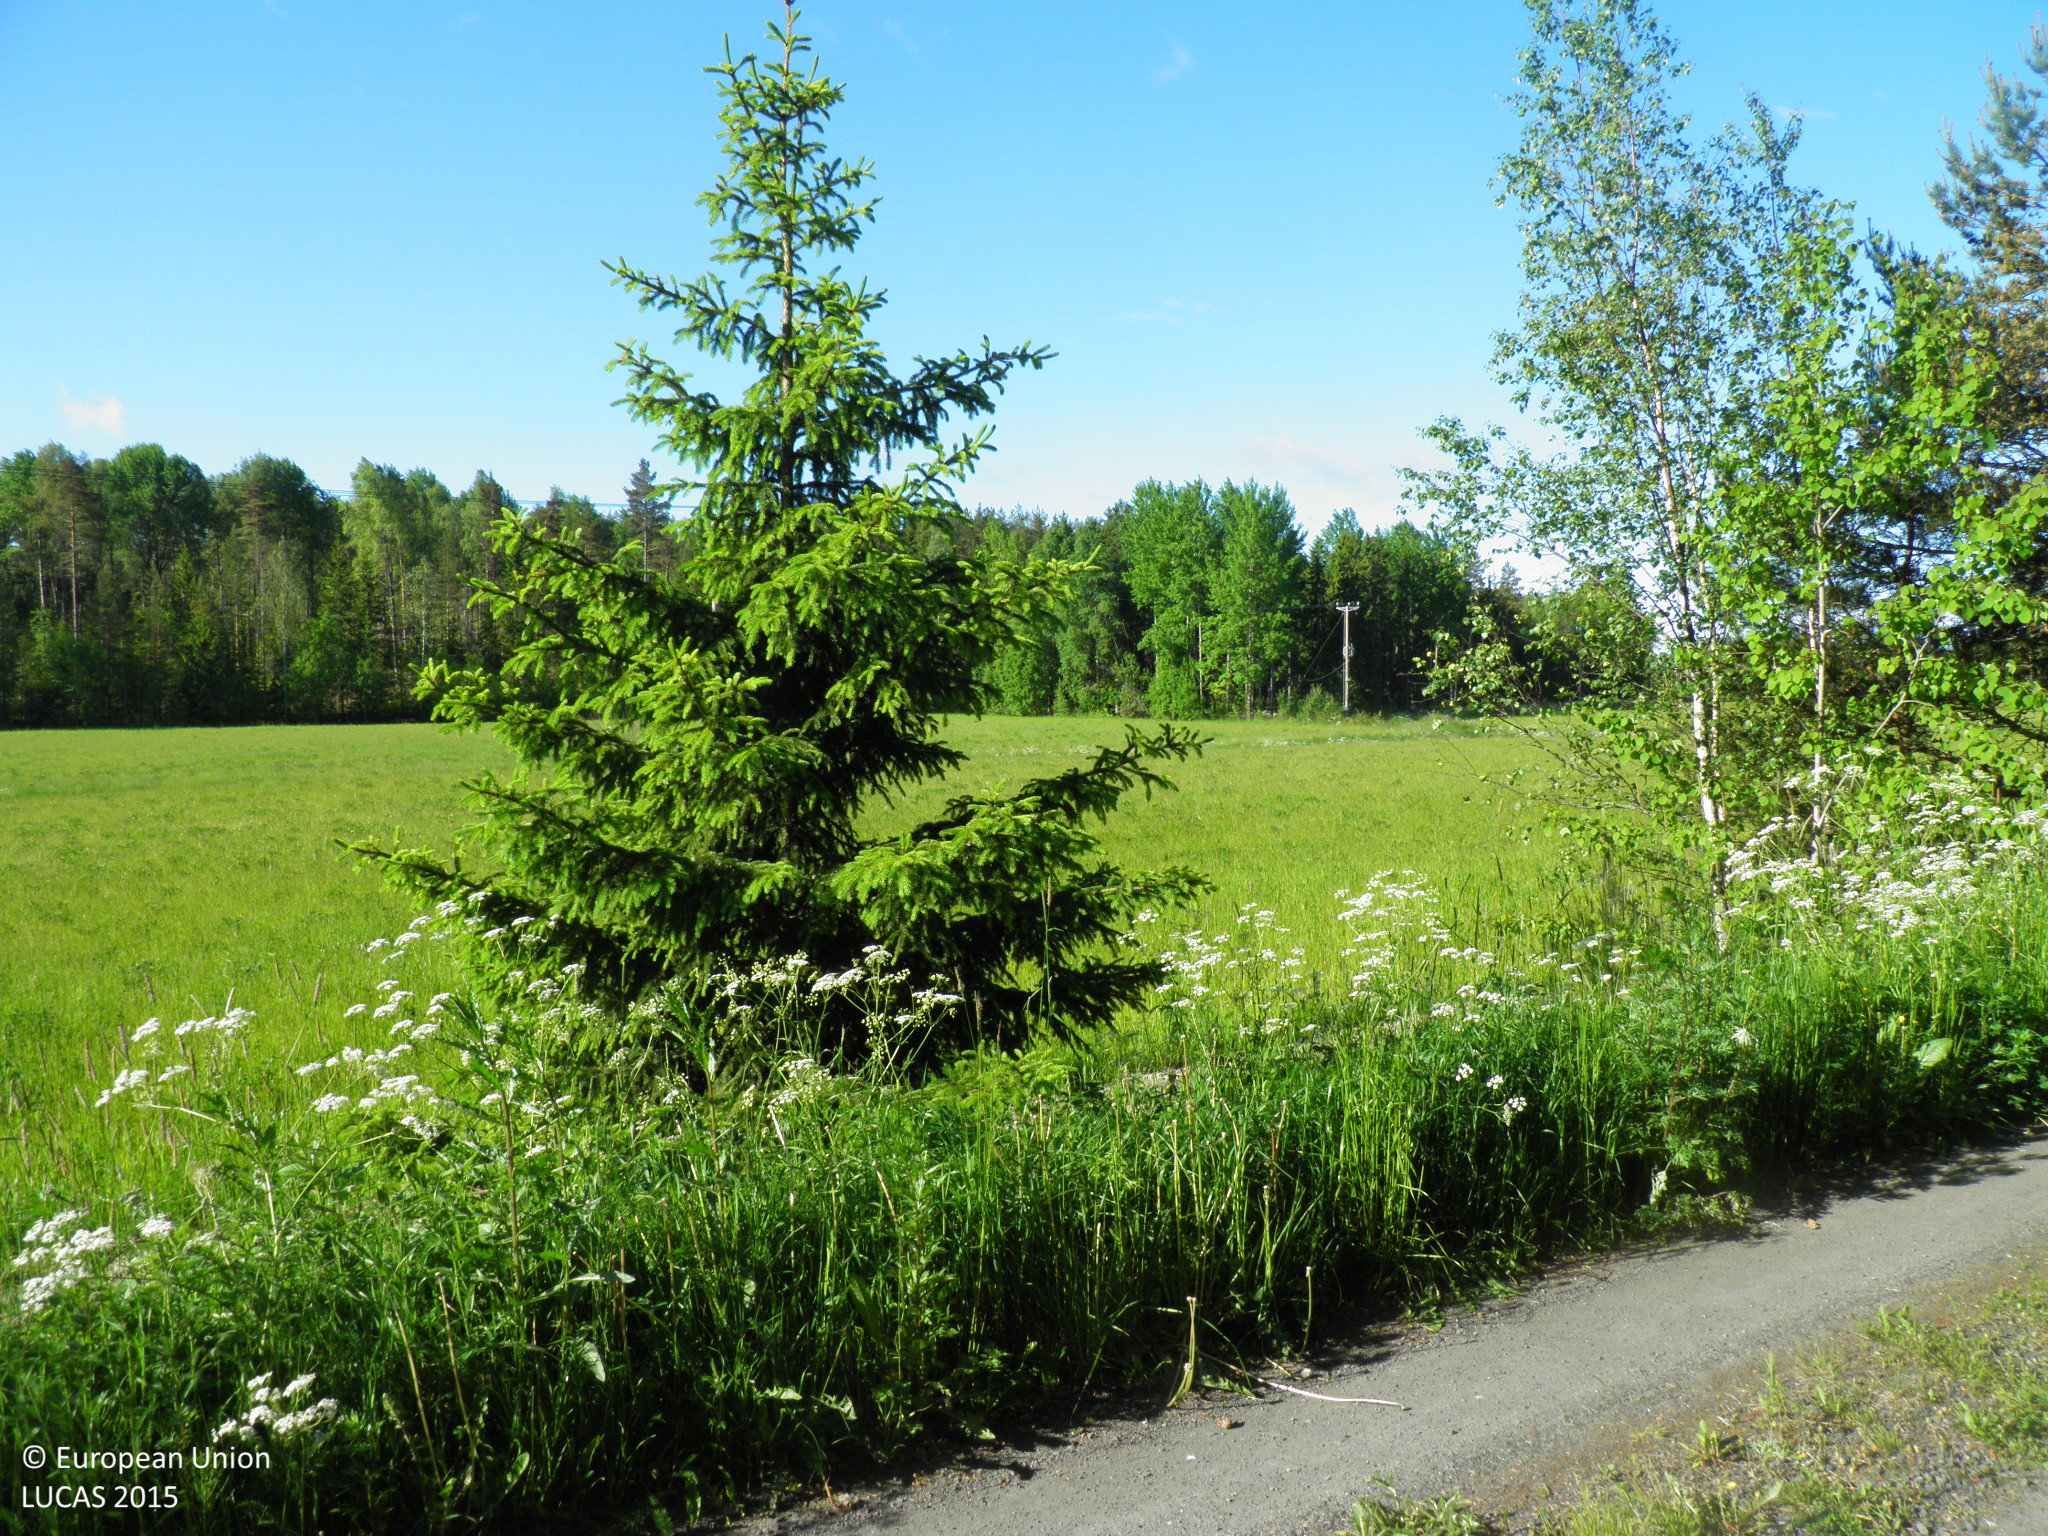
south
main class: Woodland
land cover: Pine dominated coniferous woodland
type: boreal forest
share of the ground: > 75 %
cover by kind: coniferous forest trees 70 %, broadleaved forest trees 10 %, shrubs 10 %, herbaceous plants 10 %
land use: Forestry
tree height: > 5 m
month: June
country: FI
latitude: 60.4035
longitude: 22.5416
